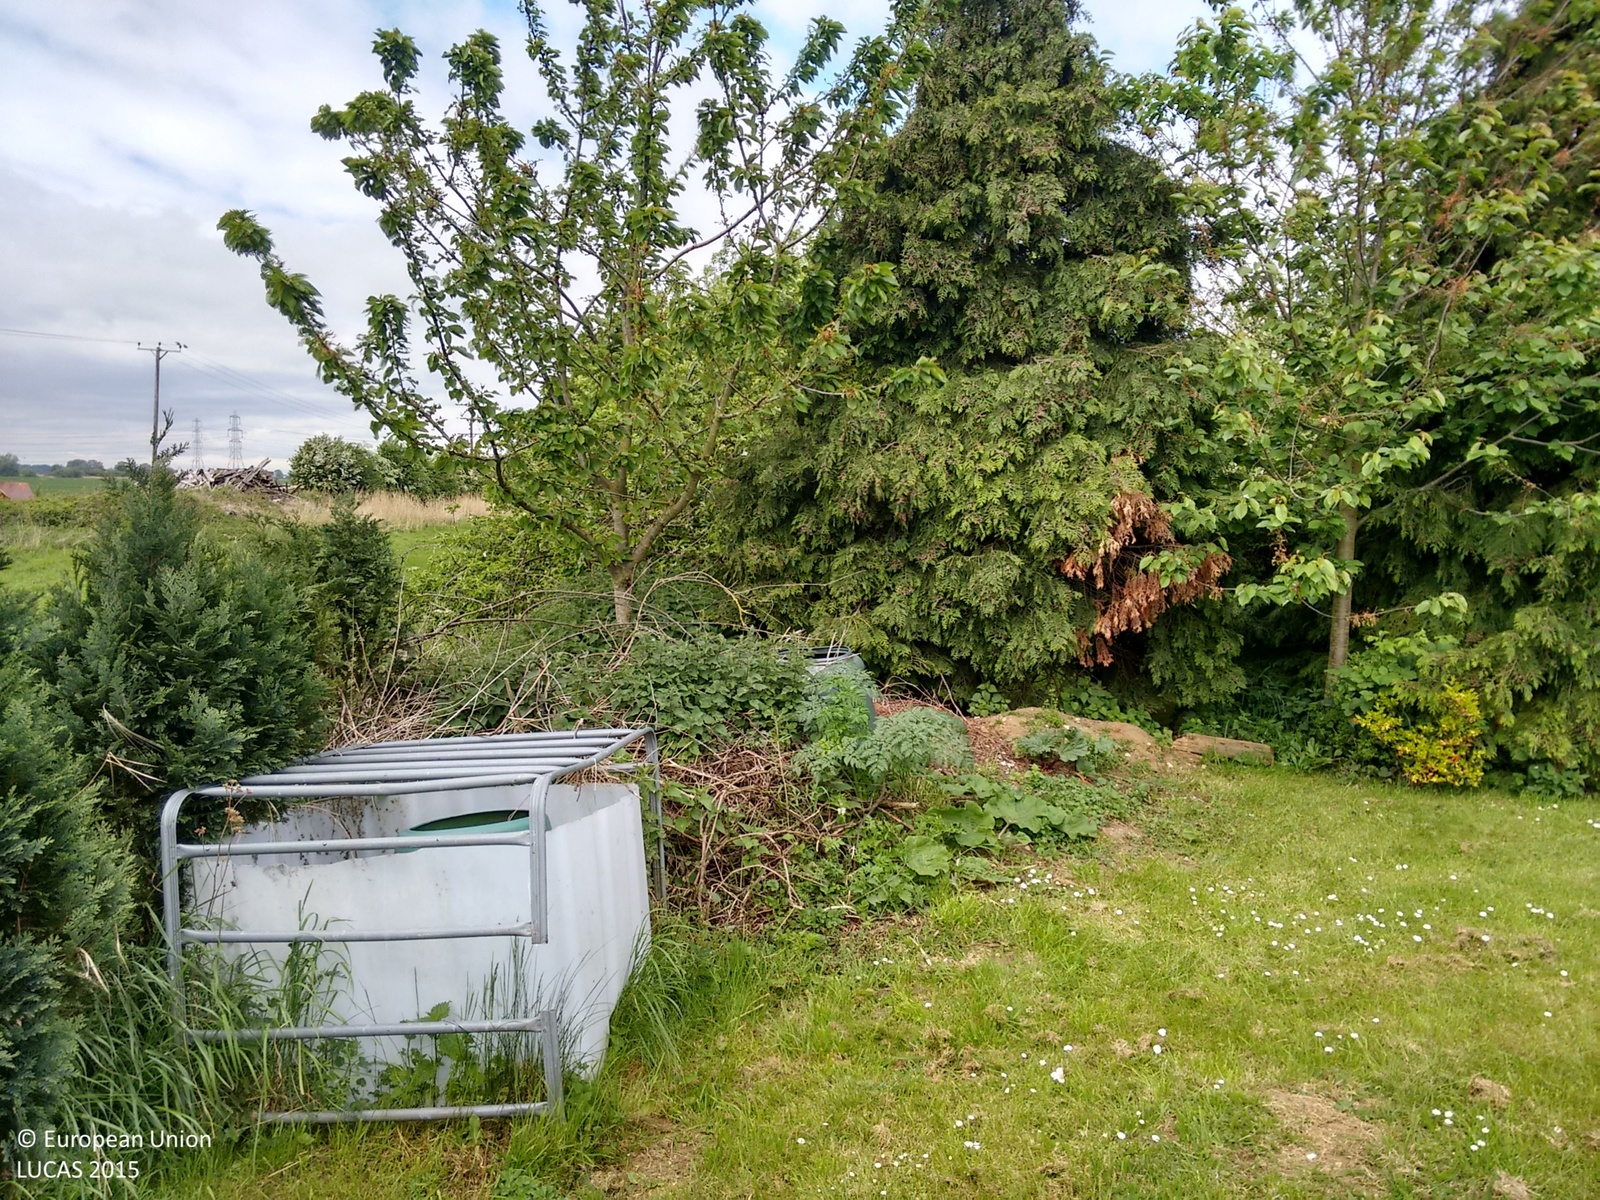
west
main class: Grassland
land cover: Grassland without tree/shrub cover
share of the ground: > 75 %
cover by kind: herbaceous plants 100 %
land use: Residential
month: May
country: GB
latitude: 53.5753
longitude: -0.7476
